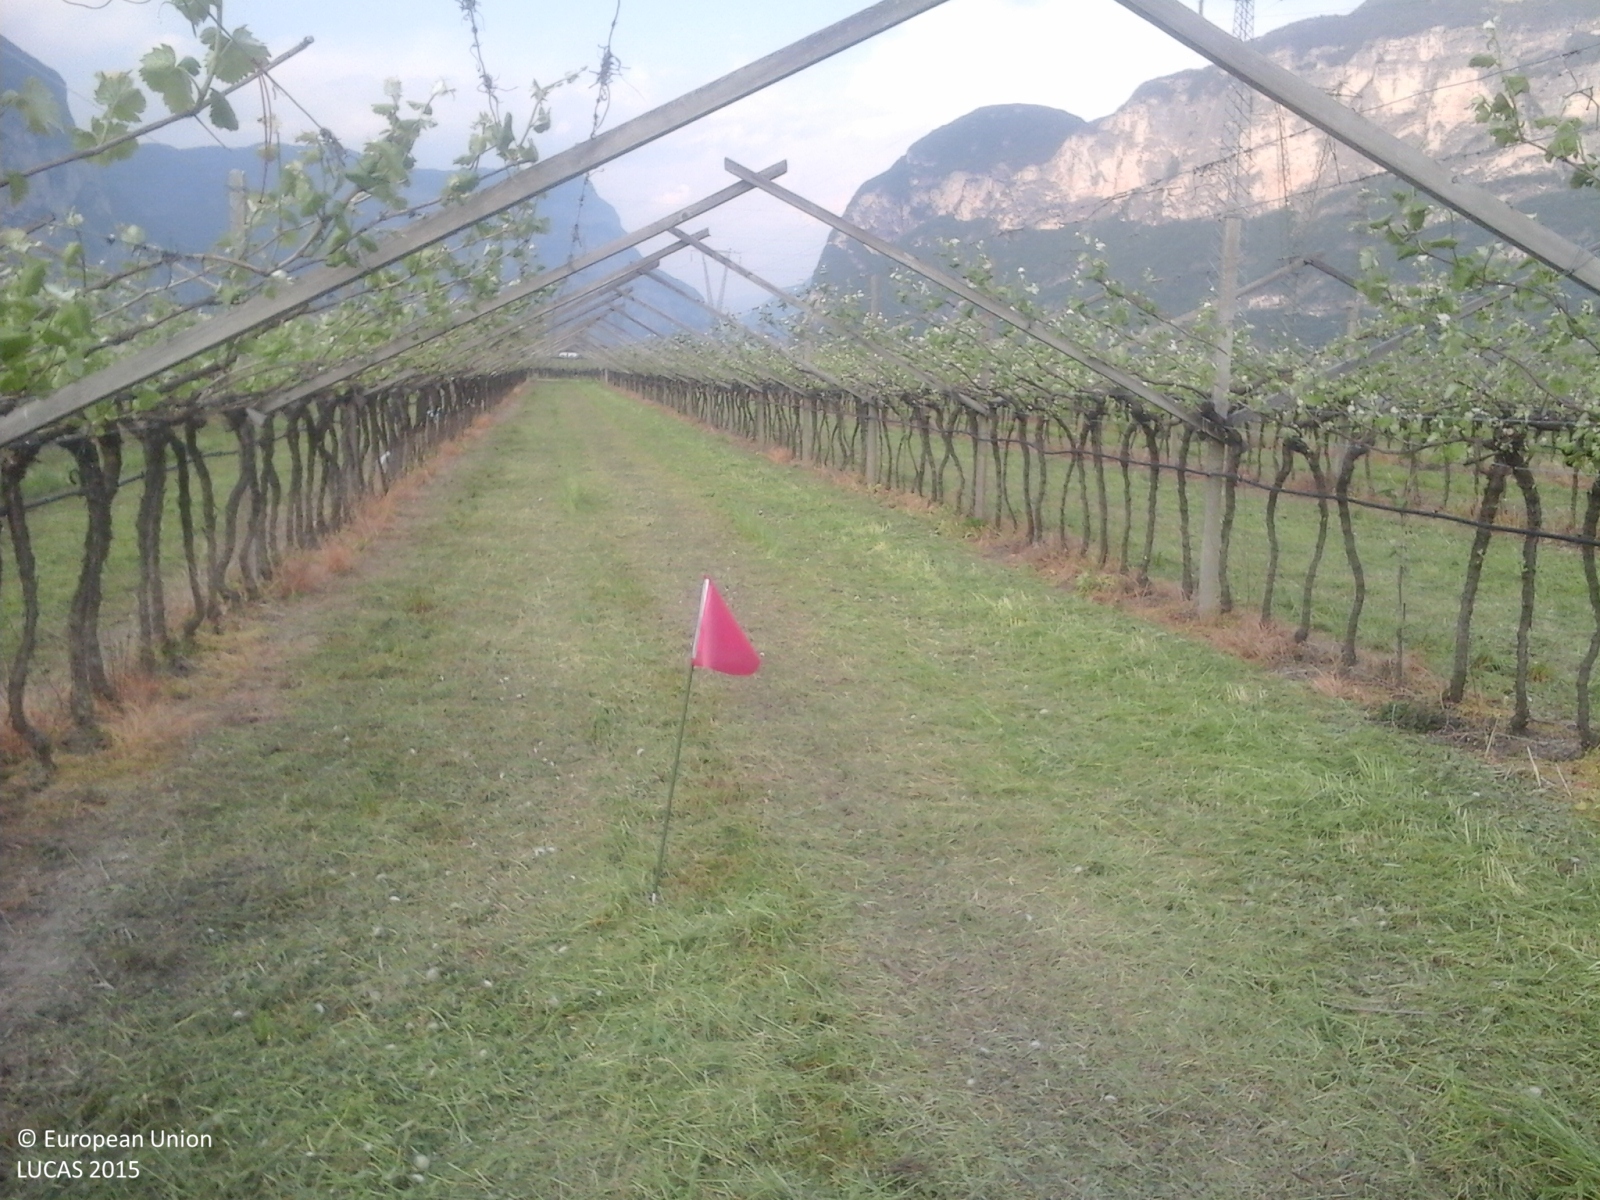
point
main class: Cropland
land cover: Vineyards
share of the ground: 10 - 25 %
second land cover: Grassland without tree/shrub cover
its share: > 75 %
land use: Agriculture (excluding fallow land and kitchen gardens)
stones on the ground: < 10 %
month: April
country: IT
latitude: 46.2012
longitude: 11.1259
